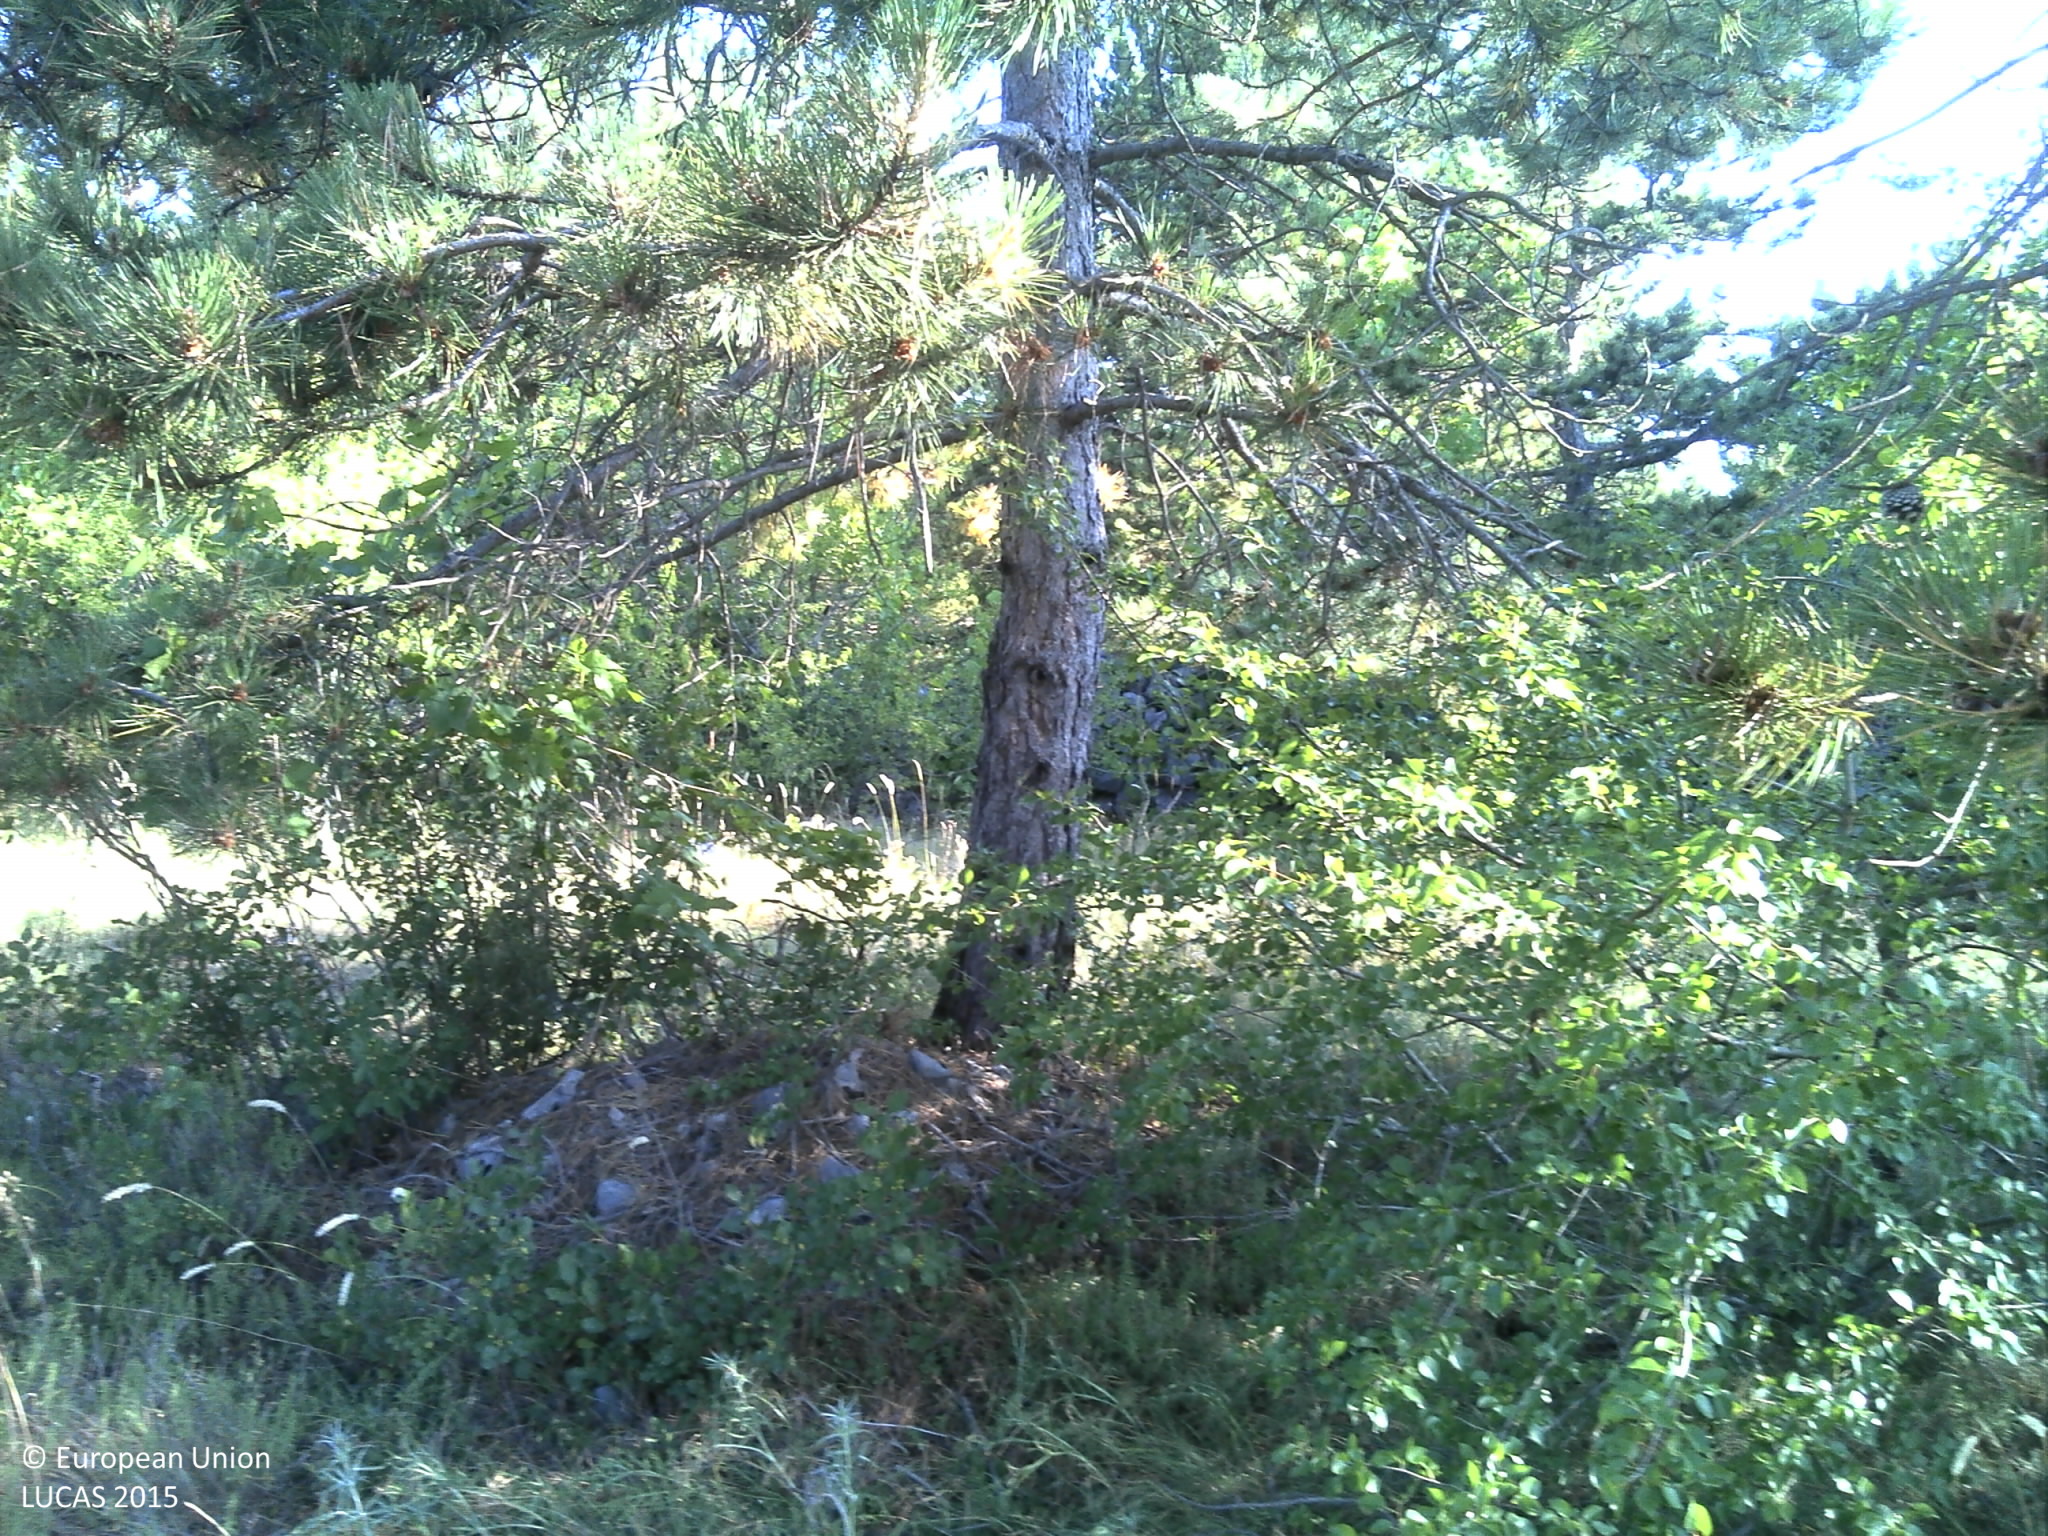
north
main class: Woodland
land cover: Pine dominated coniferous woodland
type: coniferous forest of the mediterranean region
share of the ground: 50 - 75 %
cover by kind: coniferous forest trees 60 %, herbaceous plants 25 %, shrubs 5 %, consolidated bare surface 5 %, unconsolidated bare surface 5 %
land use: Semi-natural and natural areas not in use
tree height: > 5 m
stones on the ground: < 10 %
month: July
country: HR
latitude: 43.4983
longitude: 17.0039
